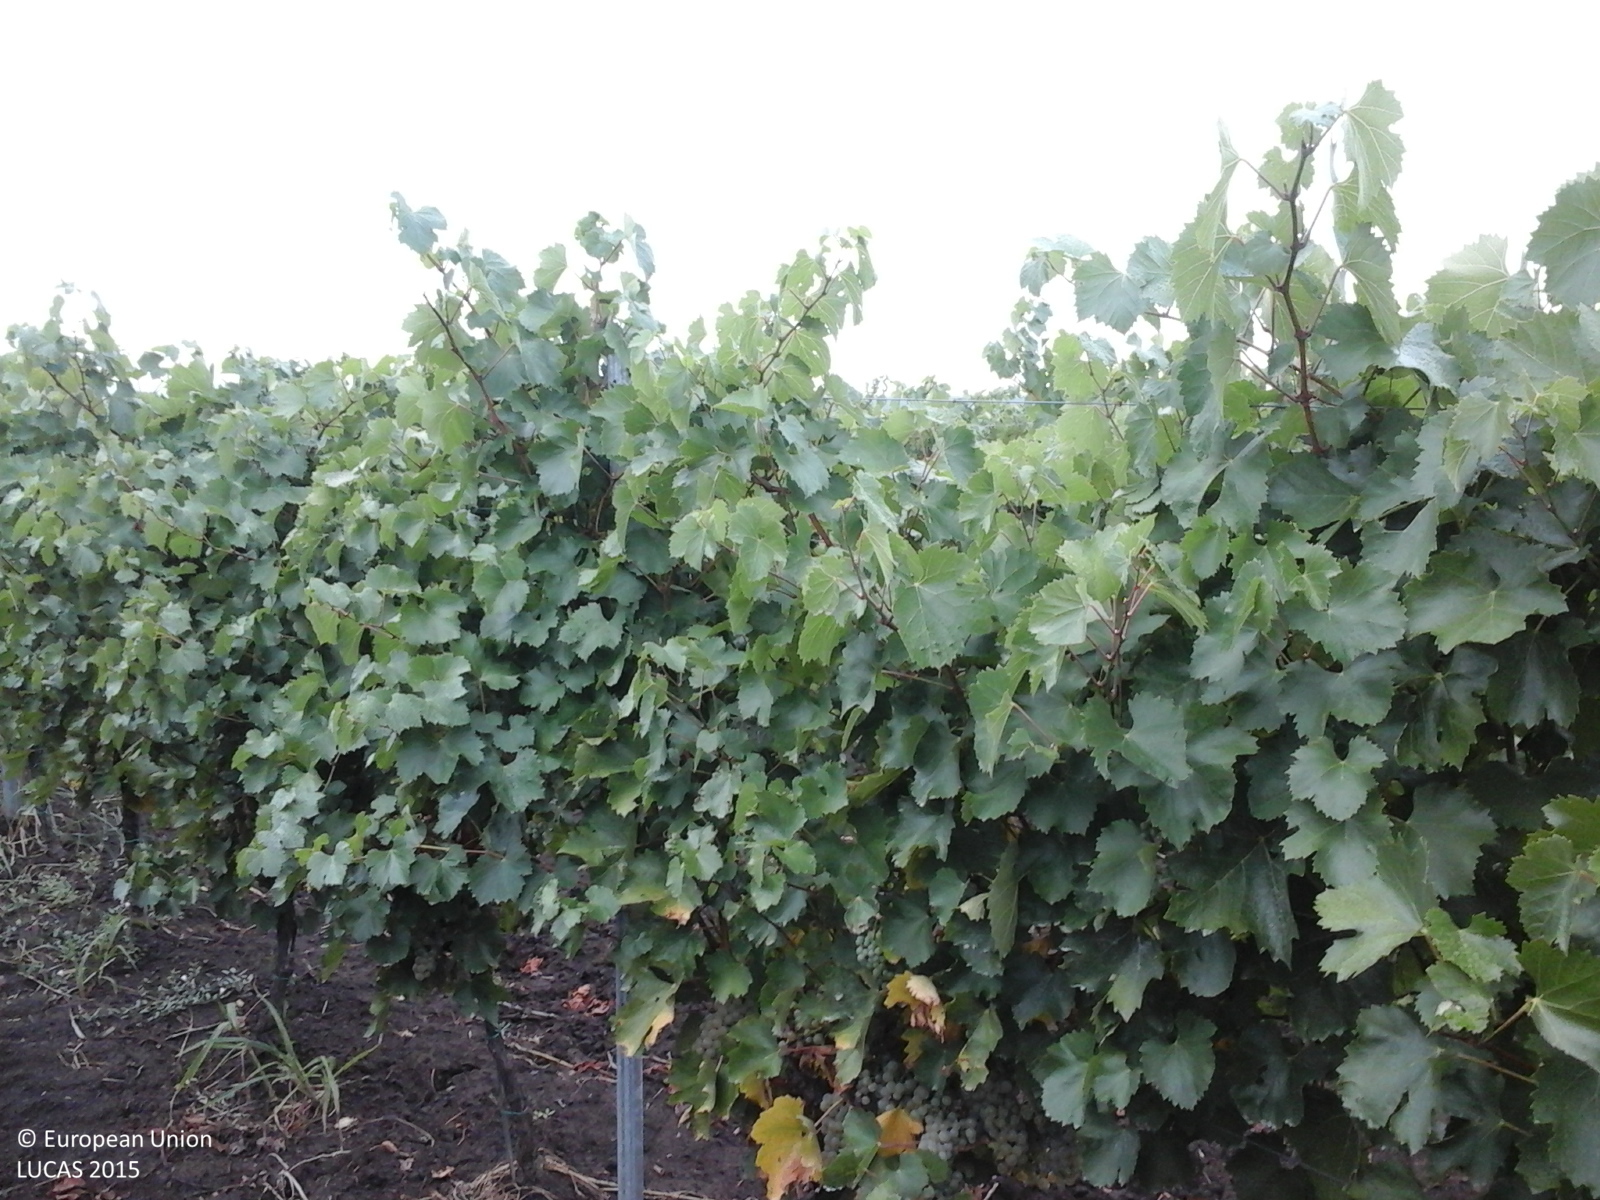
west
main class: Cropland
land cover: Vineyards
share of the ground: 50 - 75 %
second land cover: Other bare soil
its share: > 75 %
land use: Agriculture (excluding fallow land and kitchen gardens)
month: August
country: RO
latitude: 45.8372
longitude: 21.5057
